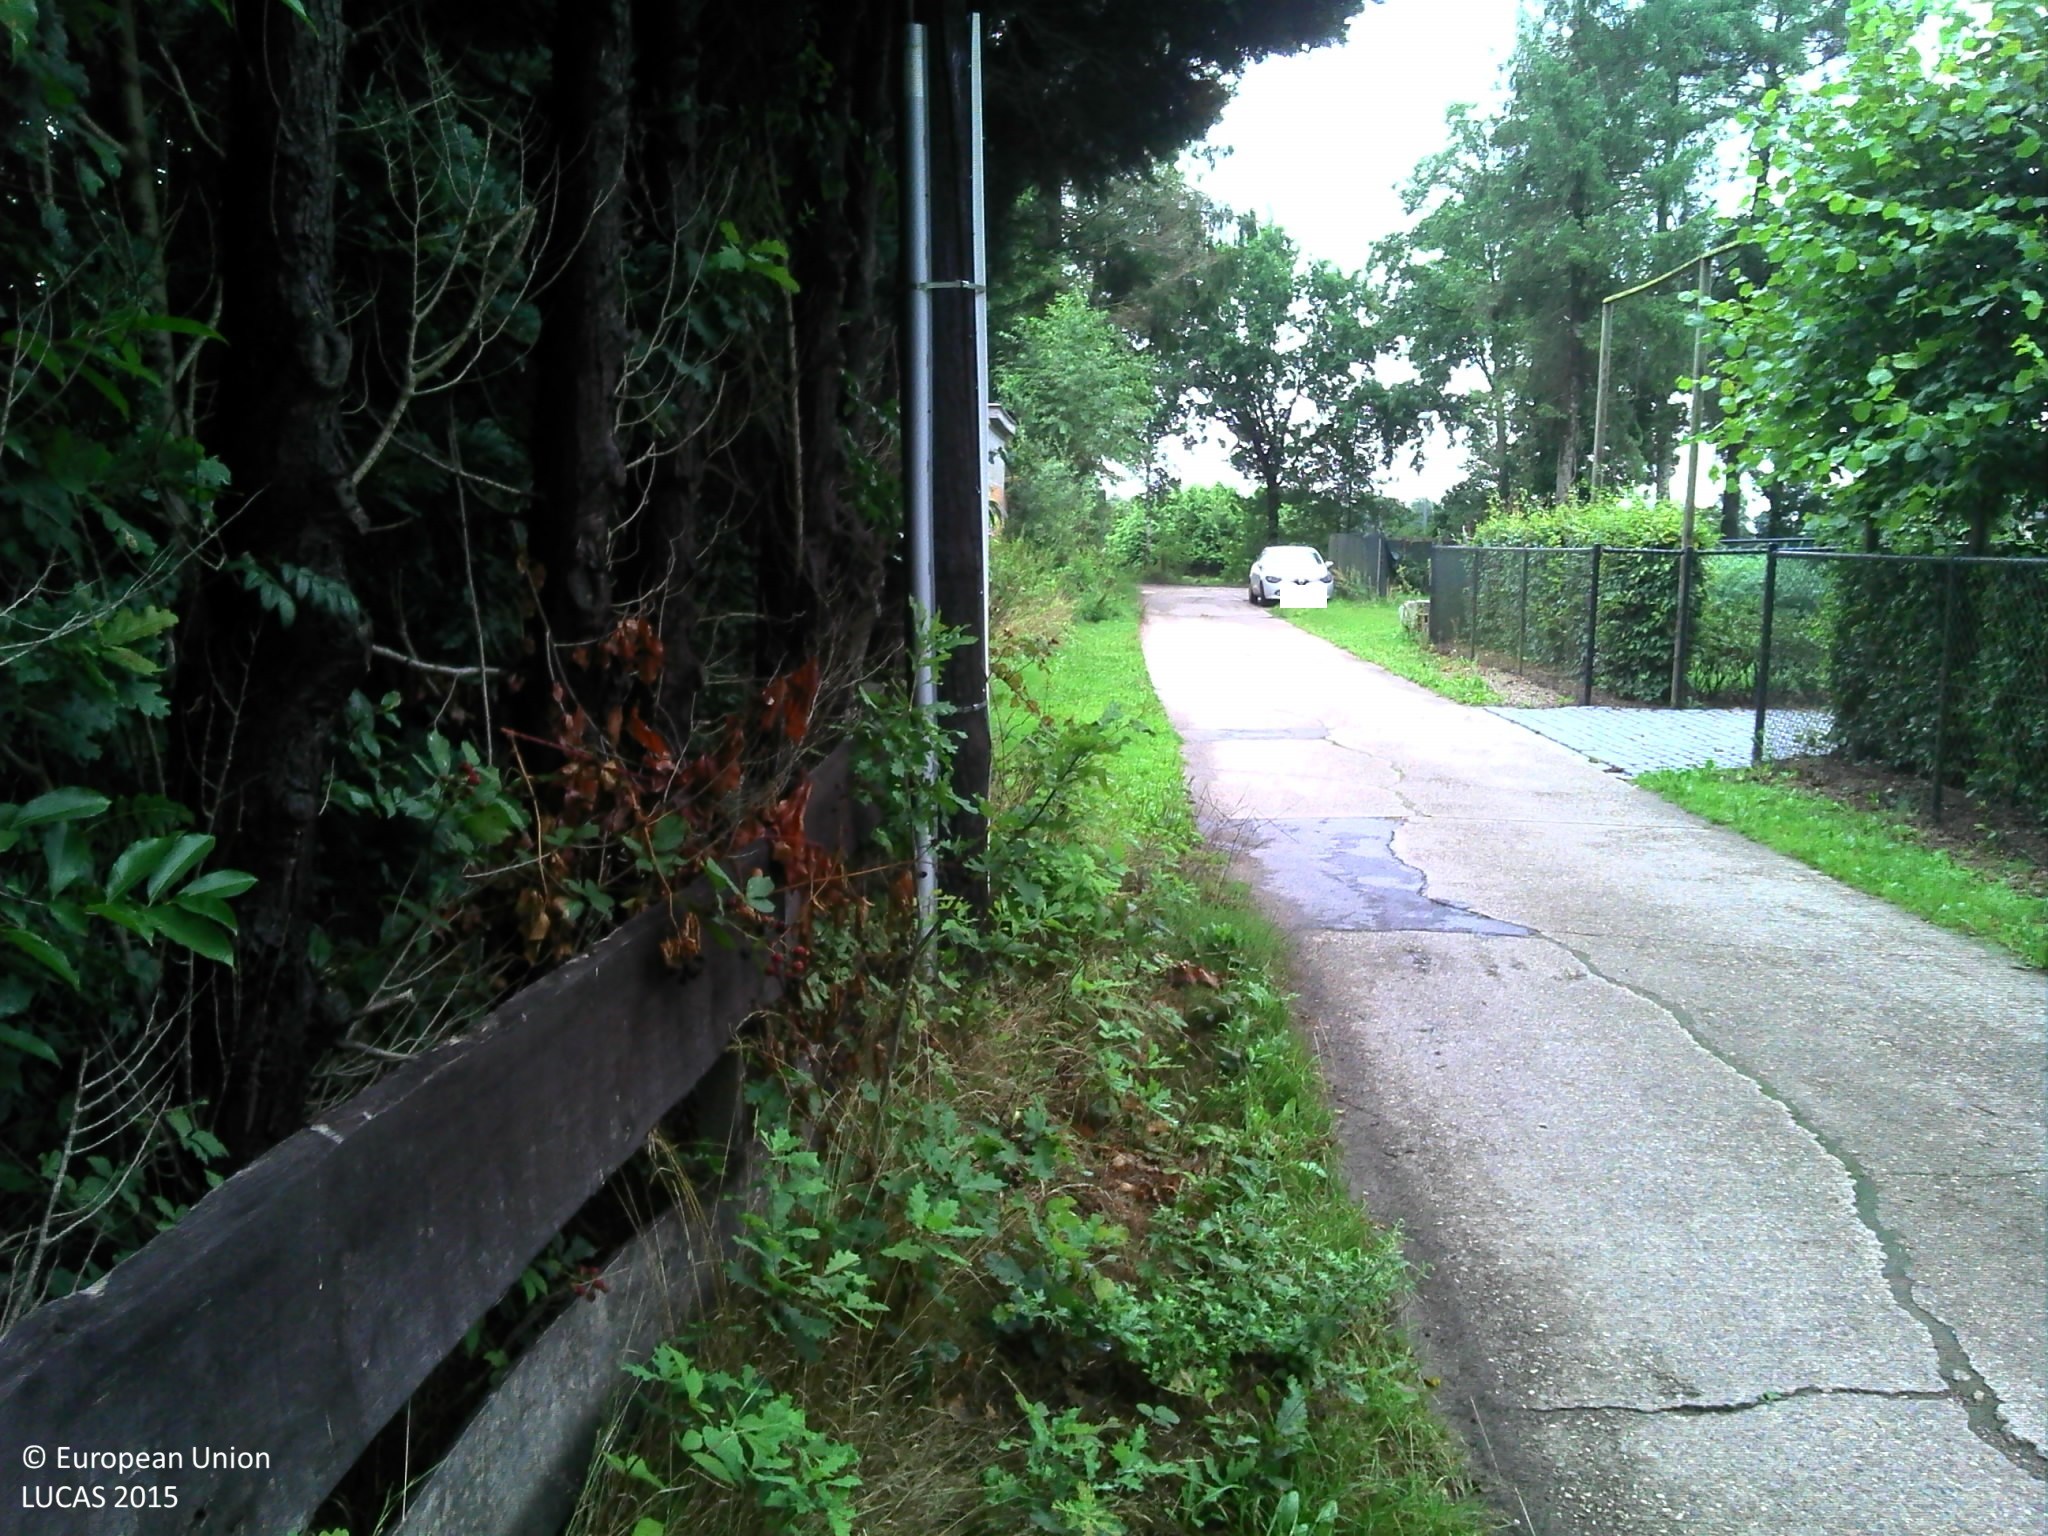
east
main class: Woodland
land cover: Pine dominated coniferous woodland
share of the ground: > 75 %
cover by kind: coniferous forest trees 90 %, broadleaved forest trees 10 %
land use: Residential
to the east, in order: Pine dominated coniferous woodland; Artificial constructions in urban areas; Lines of trees; Ditches and canals; Grass margins; Nurseries
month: August
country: BE
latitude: 51.3232
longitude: 5.1328
